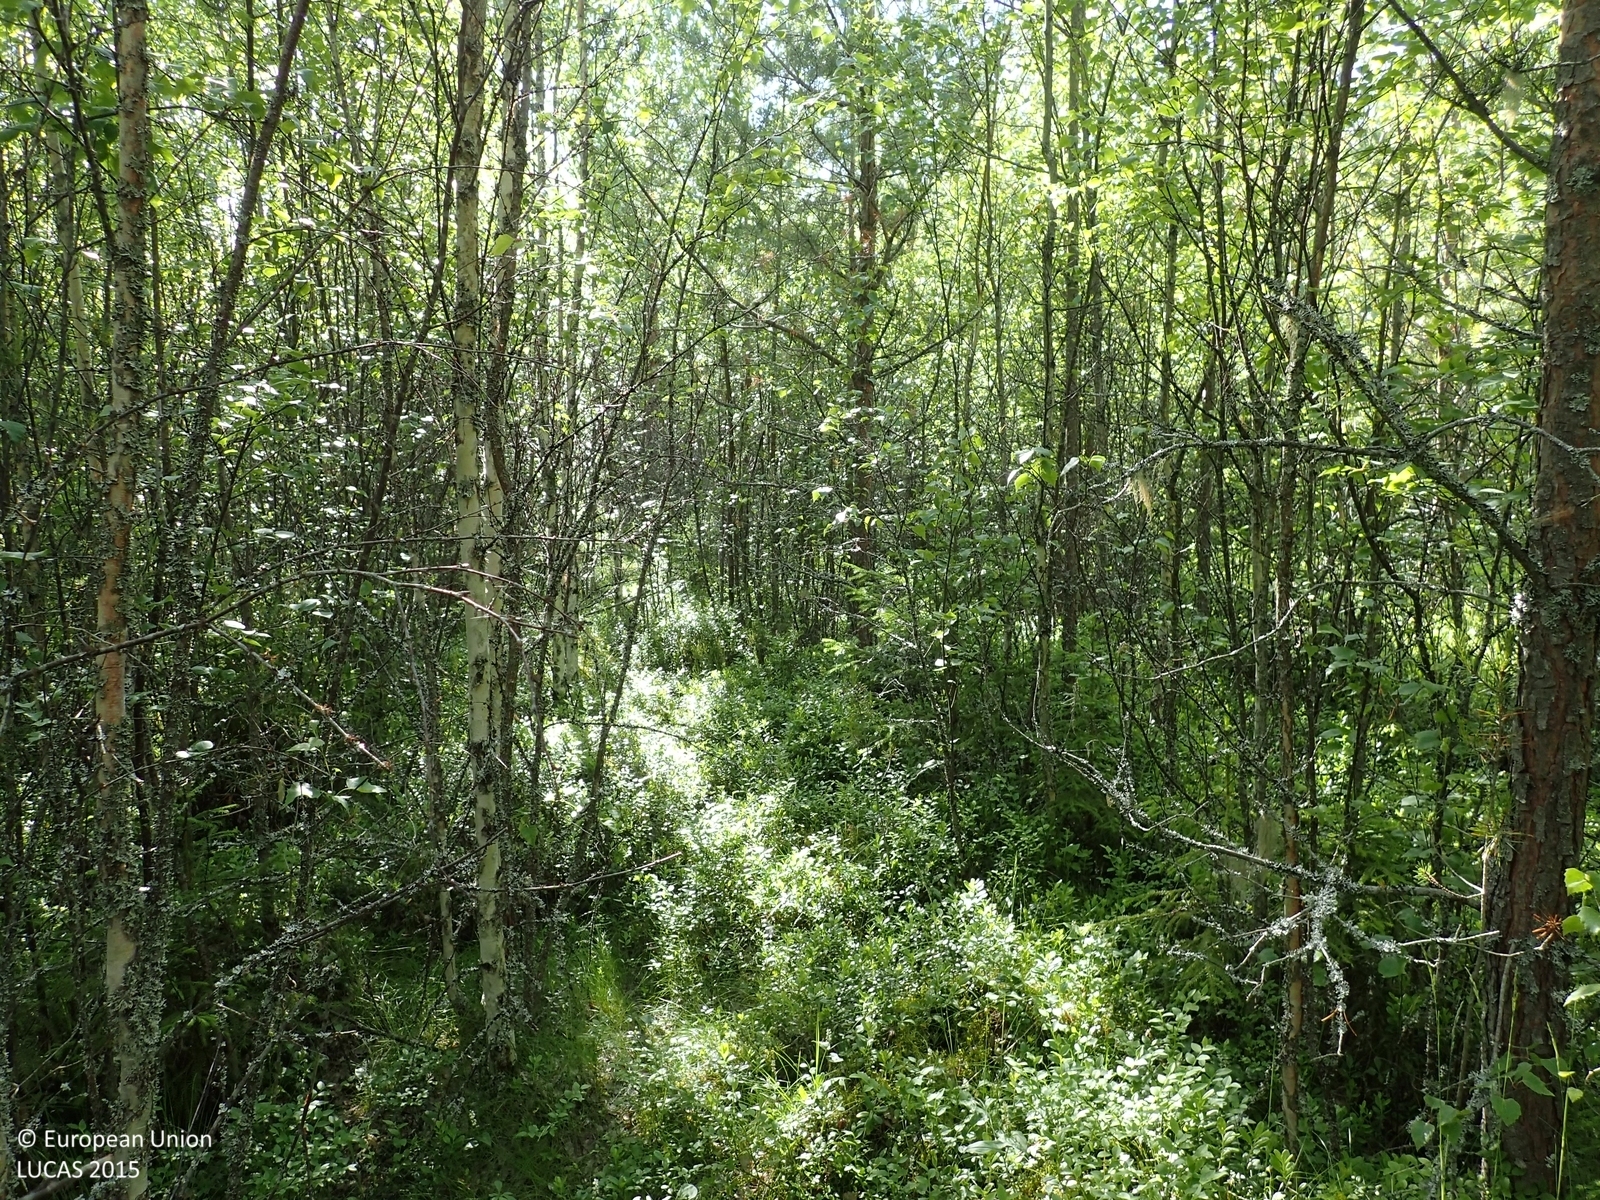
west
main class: Woodland
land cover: Pine dominated mixed woodland
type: boreal forest
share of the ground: > 75 %
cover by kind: coniferous forest trees 40 %, broadleaved forest trees 40 %, shrubs 10 %, herbaceous plants 10 %
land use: Forestry
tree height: > 5 m
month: June
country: FI
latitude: 62.5036
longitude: 21.4392
